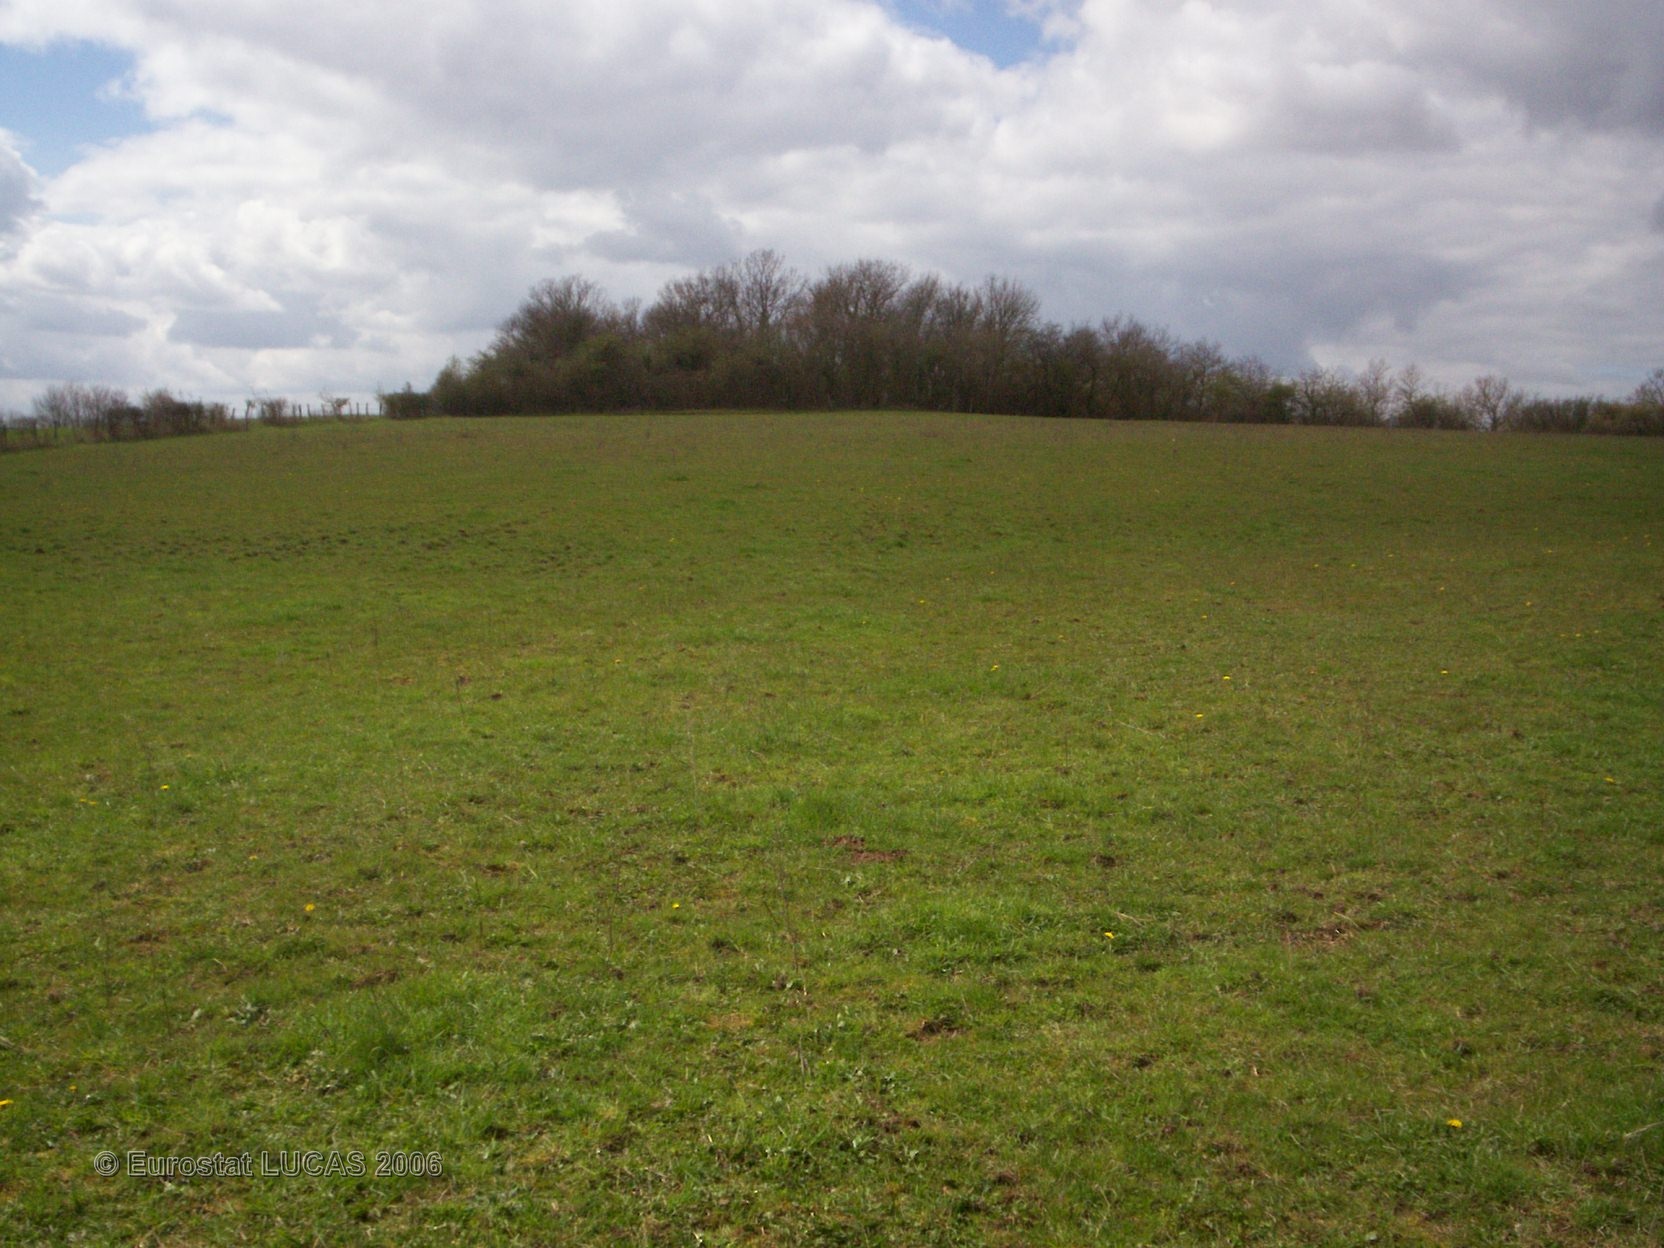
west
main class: Grassland
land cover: Grassland without tree/shrub cover
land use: Agriculture (excluding fallow land and kitchen gardens)
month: April
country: FR
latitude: 46.9219
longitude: 3.0756
